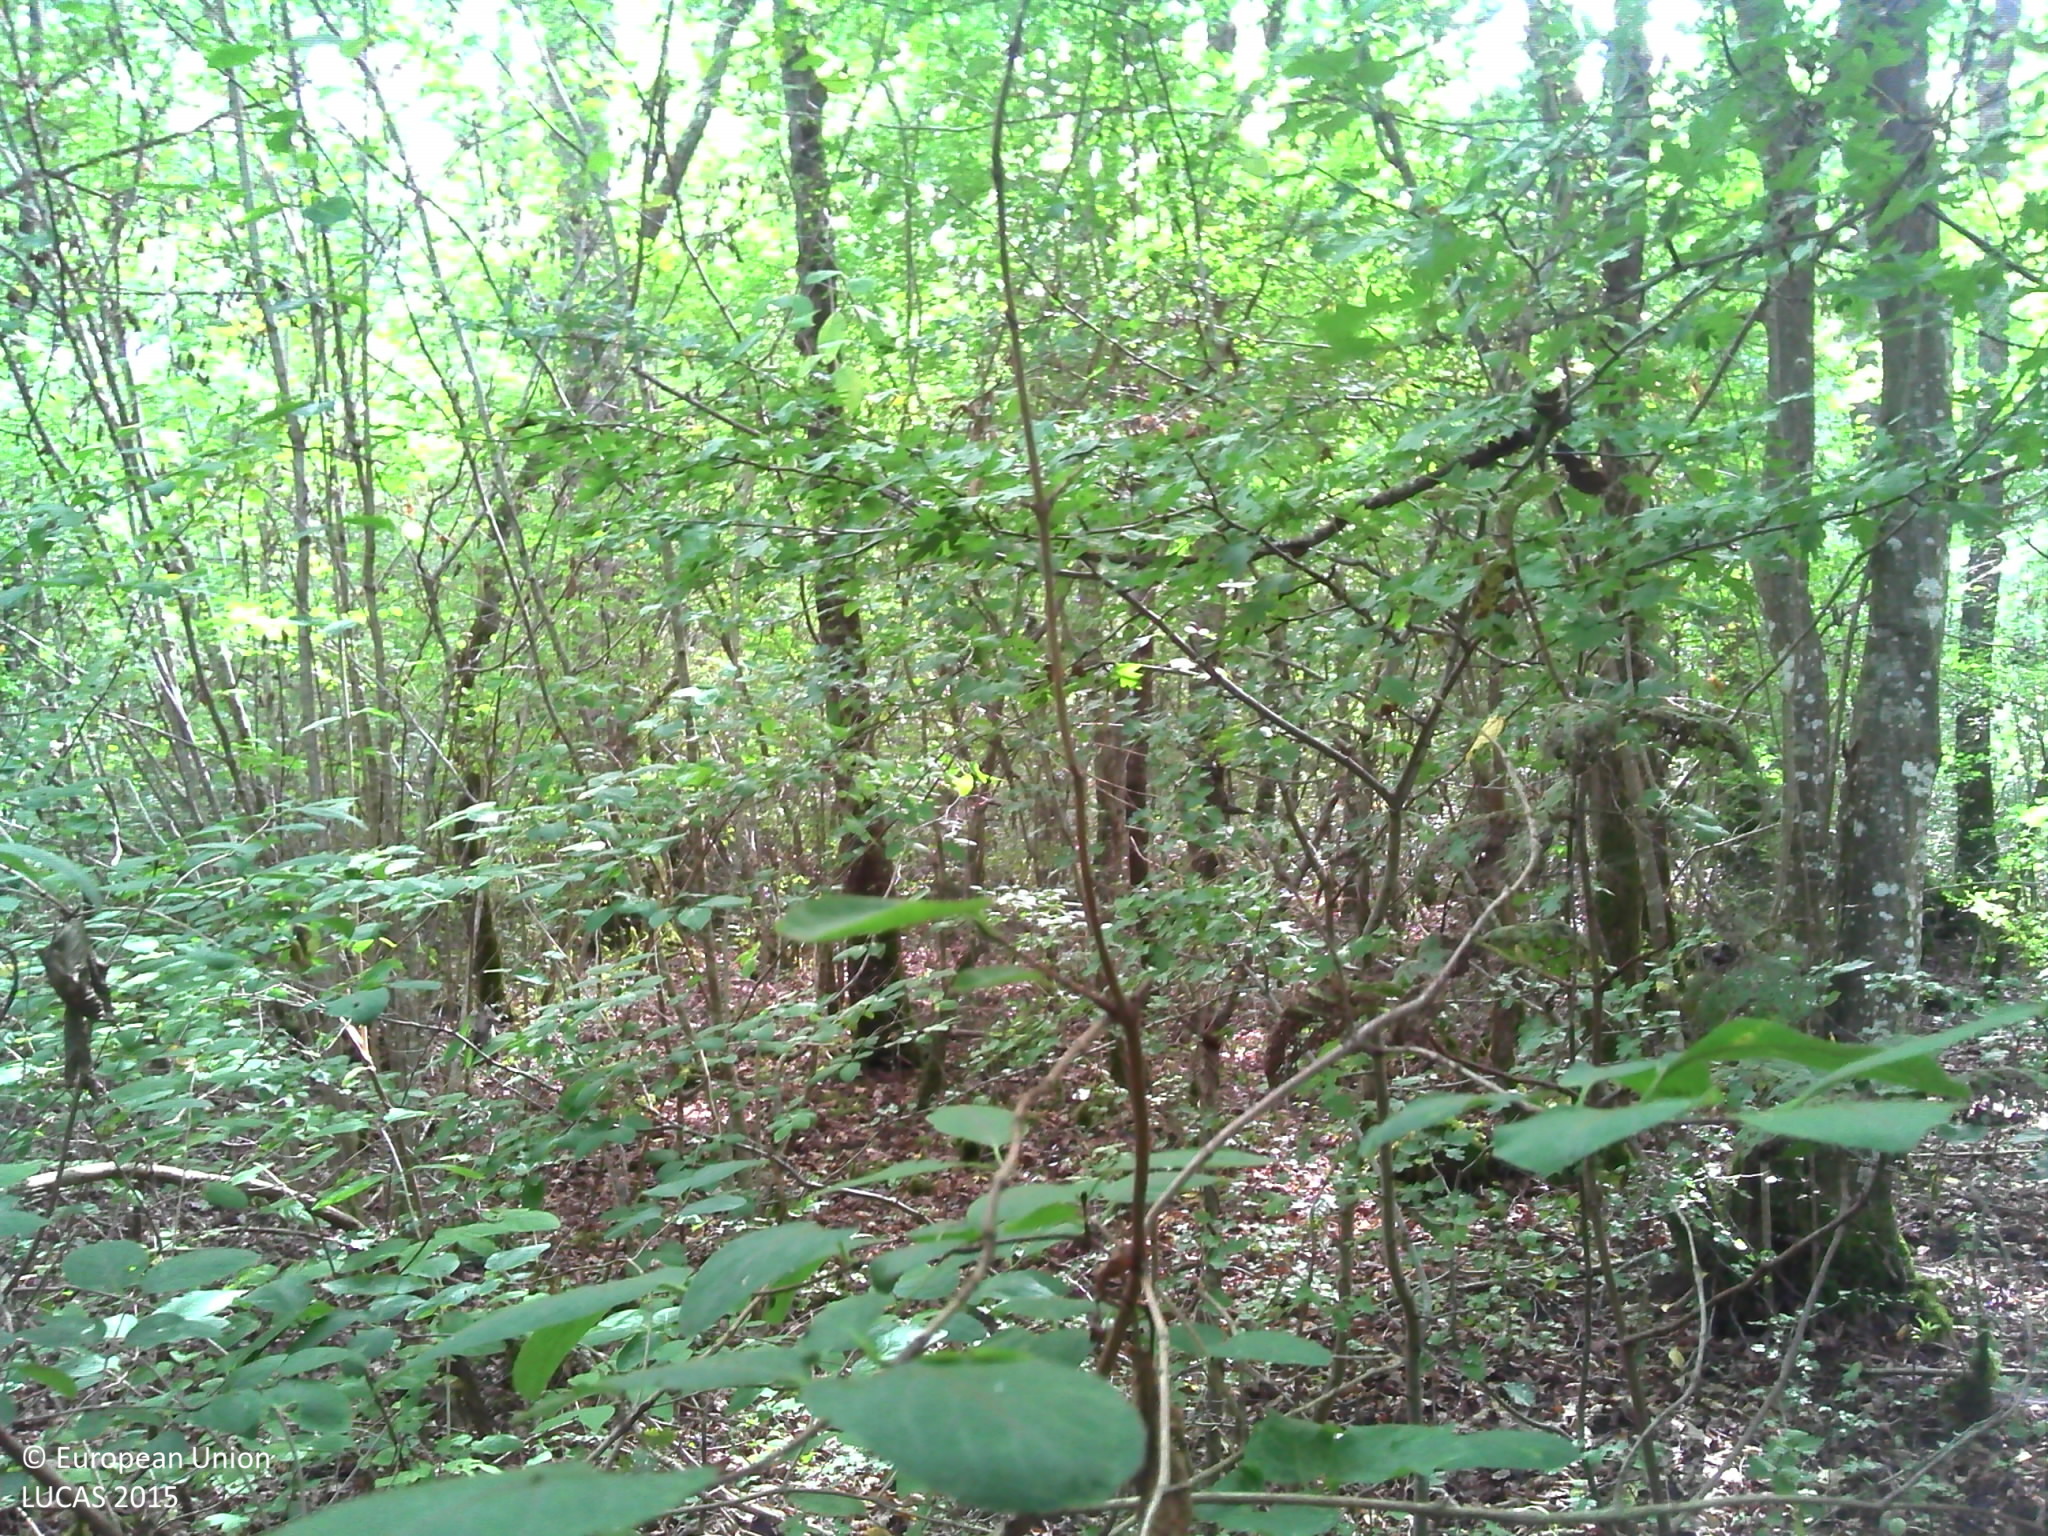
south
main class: Woodland
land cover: Broadleaved woodland
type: mesophytic deciduous forest
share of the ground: > 75 %
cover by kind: broadleaved forest trees 80 %, shrubs 10 %, herbaceous plants 10 %
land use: Forestry
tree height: > 5 m
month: September
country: FR
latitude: 48.2580
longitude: 2.7850
